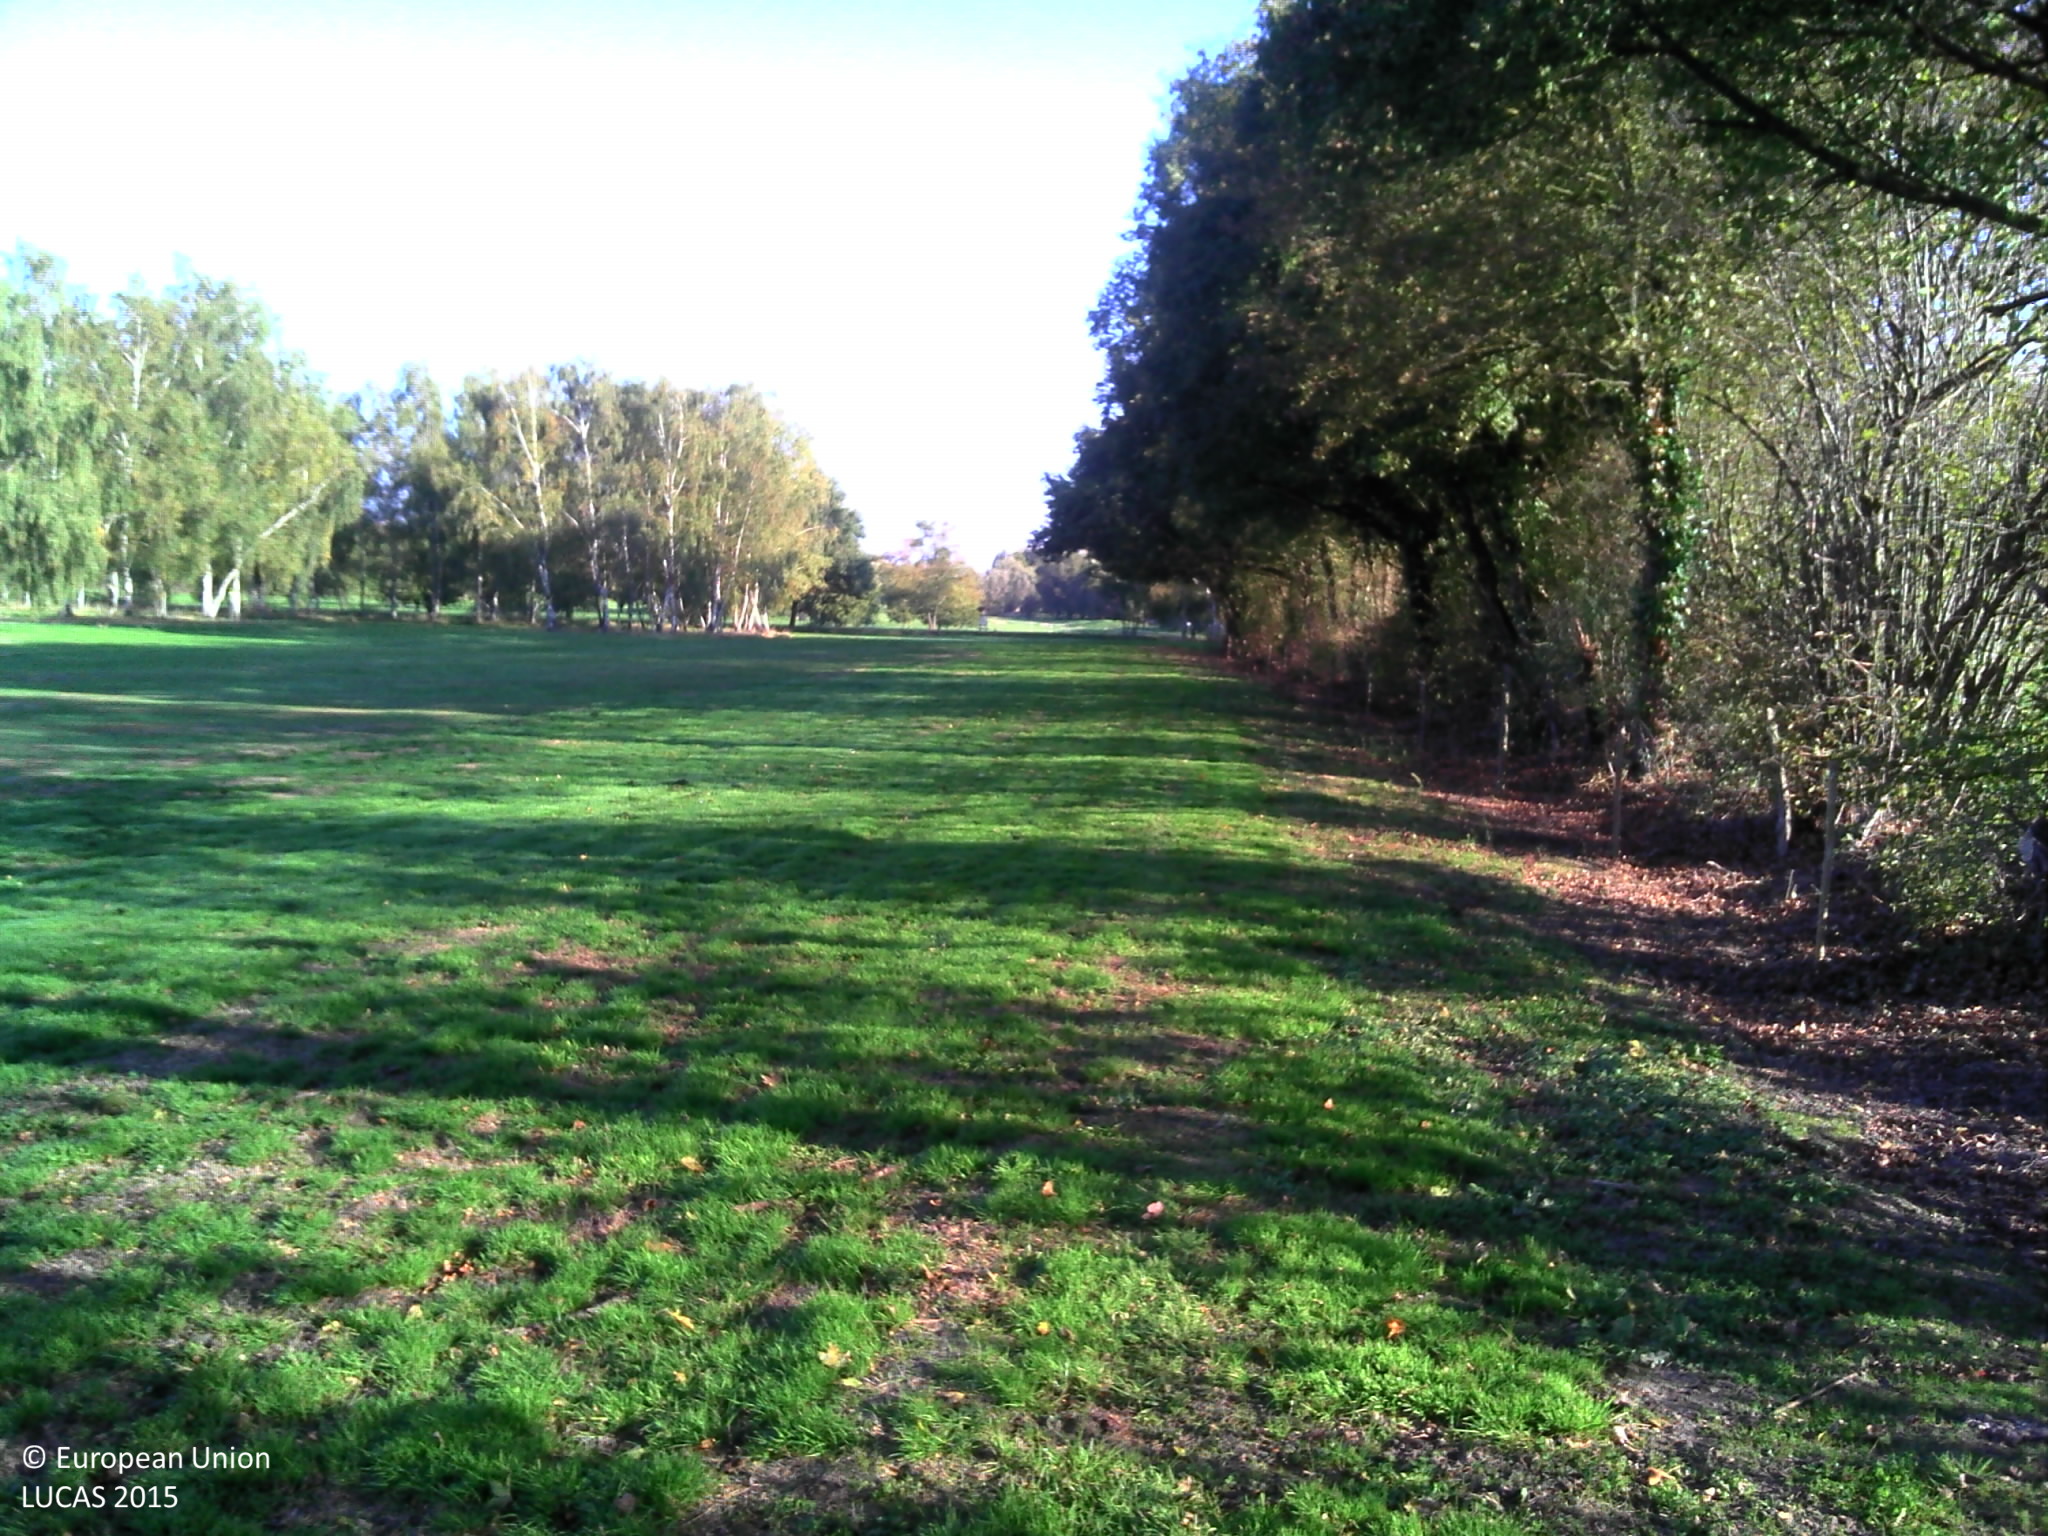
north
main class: Cropland
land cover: Temporary grasslands
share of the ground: > 75 %
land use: Agriculture (excluding fallow land and kitchen gardens)
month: October
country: FR
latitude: 45.9604
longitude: 4.9322
